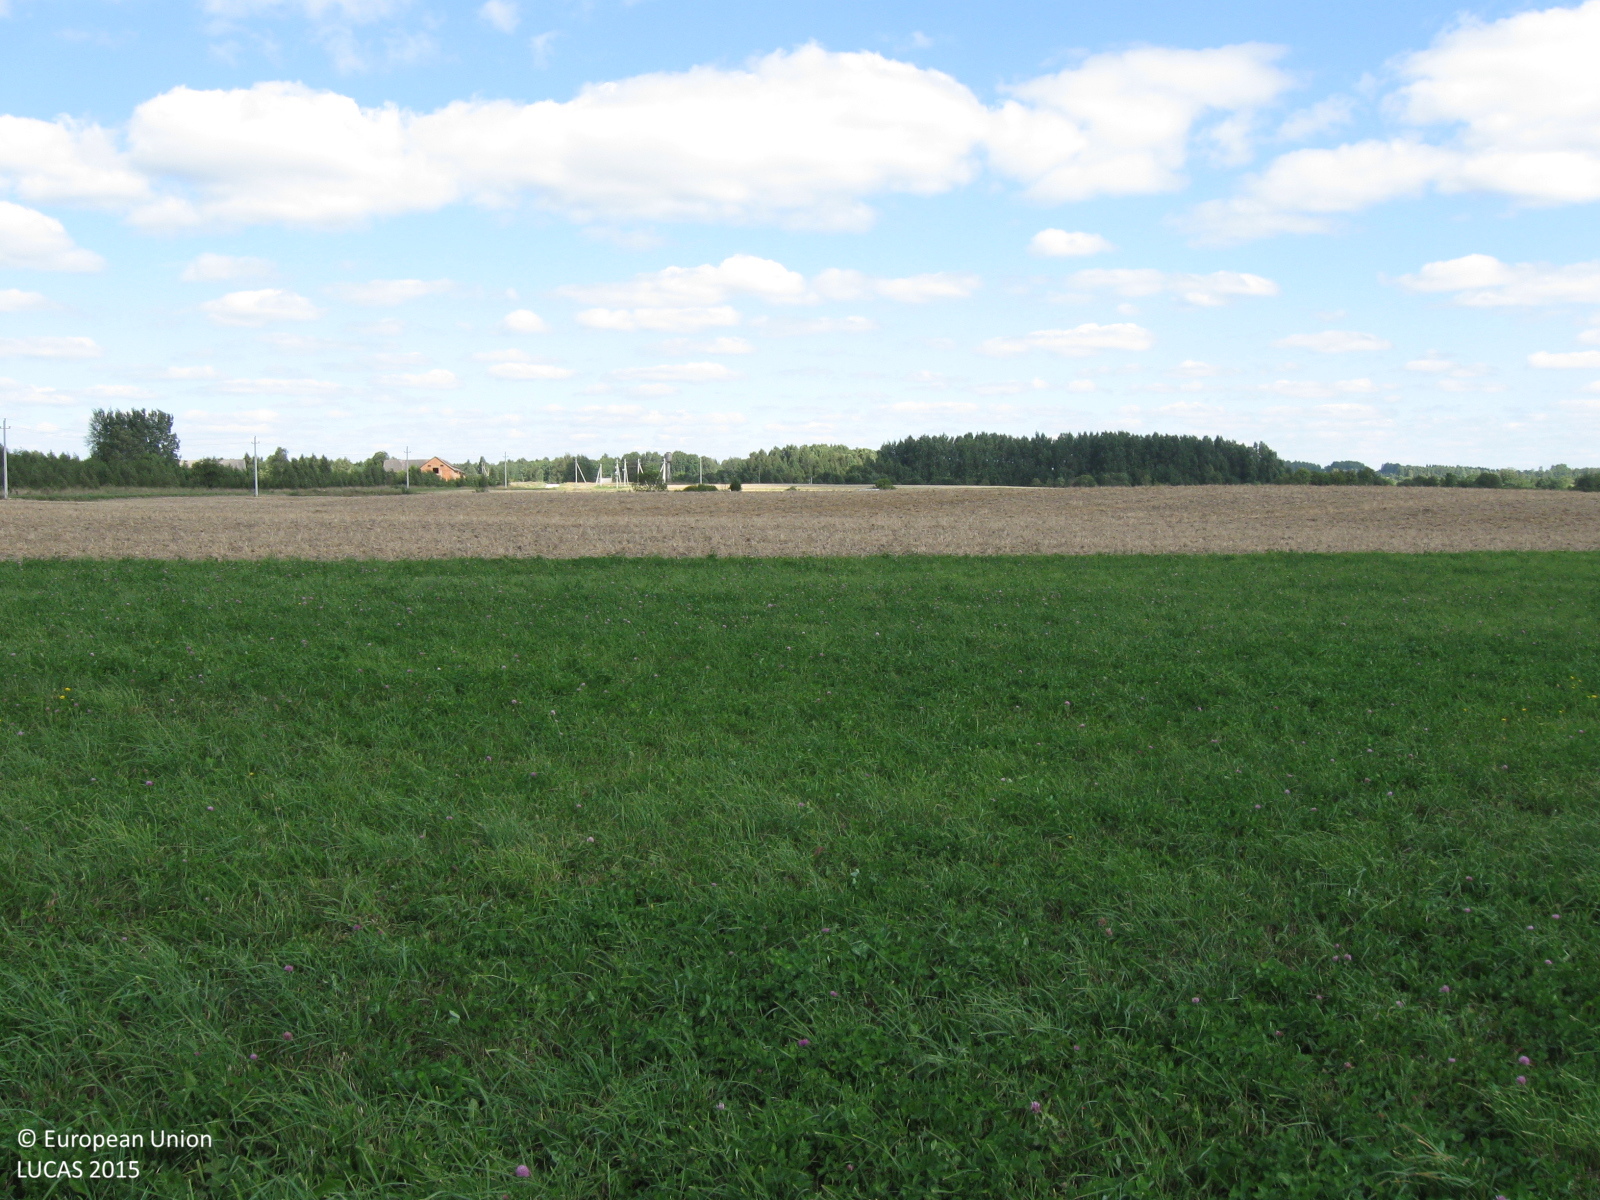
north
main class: Cropland
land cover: Other leguminous and mixtures for fodder
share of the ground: > 75 %
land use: Agriculture (excluding fallow land and kitchen gardens)
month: August
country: LT
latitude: 55.5568
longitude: 22.6672
